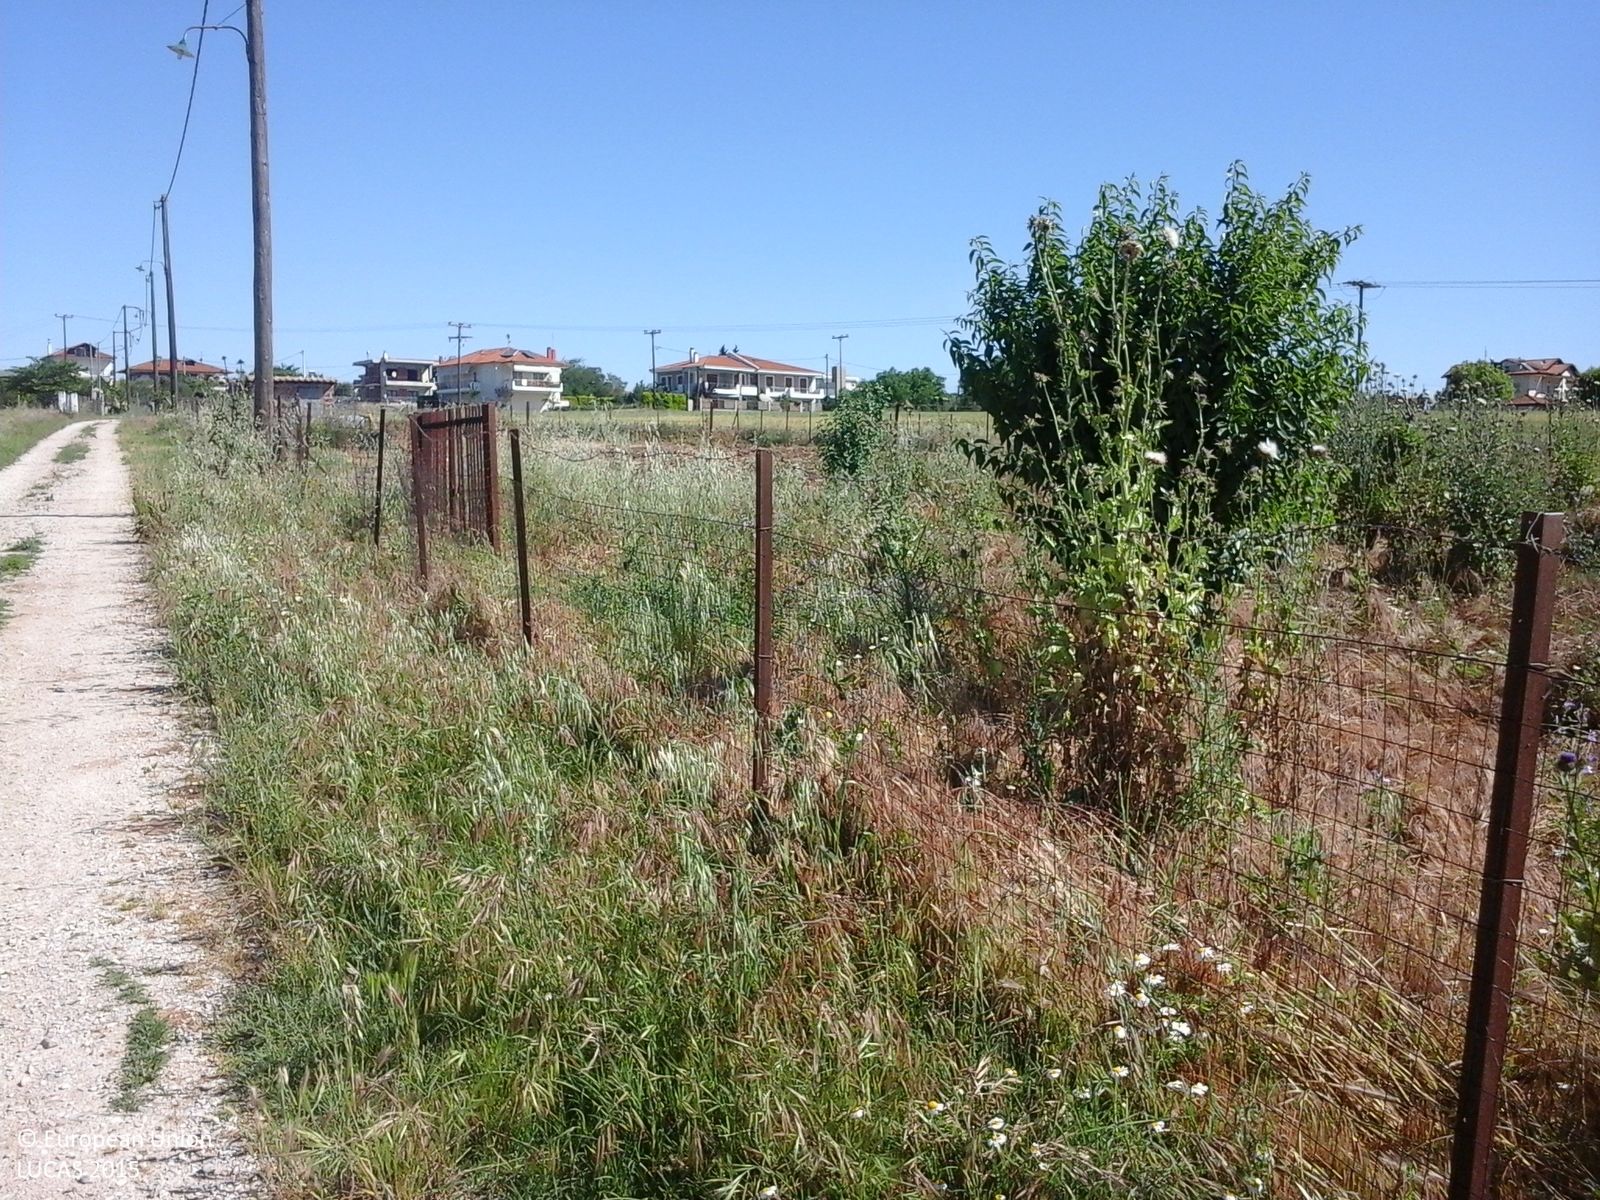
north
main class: Grassland
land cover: Spontaneously vegetated surfaces
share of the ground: > 75 %
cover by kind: herbaceous plants 10 %
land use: Fallow land
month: May
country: GR
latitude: 40.7758
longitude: 22.9593
